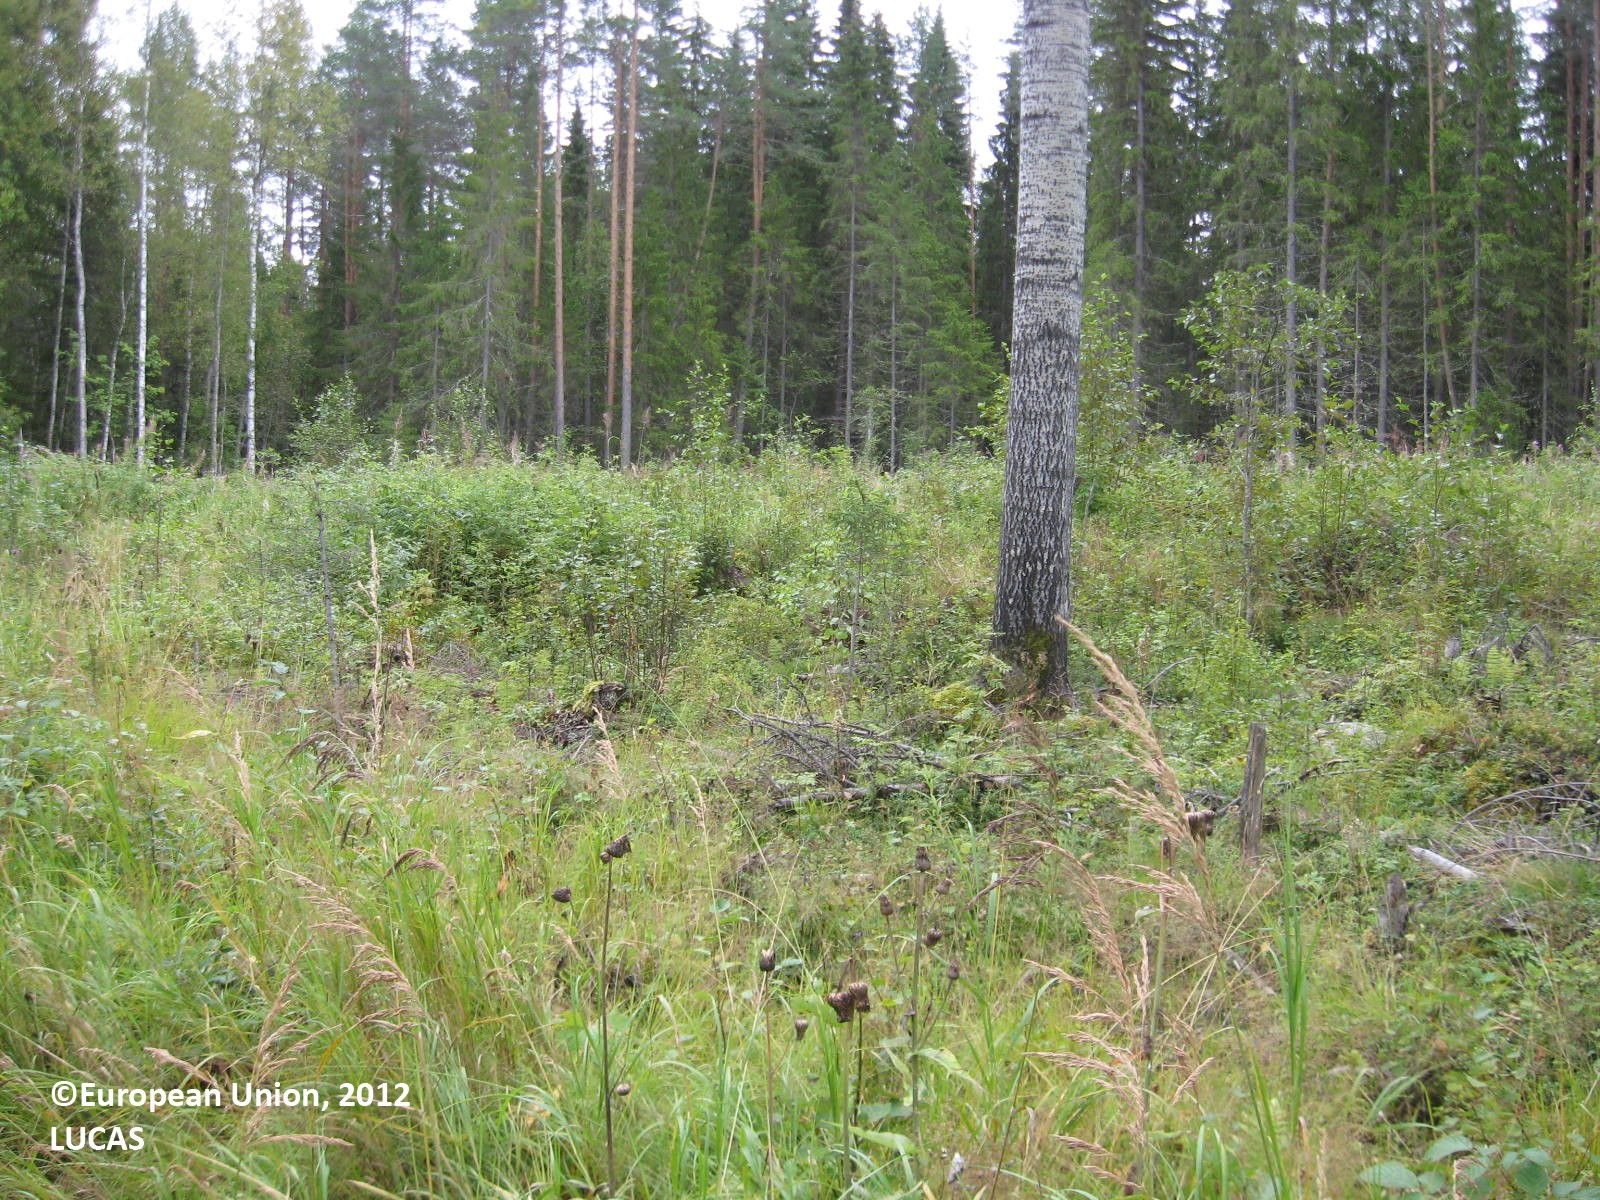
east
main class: Woodland
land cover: Broadleaved woodland
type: boreal forest
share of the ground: 25 - 50 %
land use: Forestry
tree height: > 5 m
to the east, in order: Broadleaved woodland; Pine dominated mixed woodland; Spruce dominated coniferous woodland; Other mixed woodland
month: August
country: FI
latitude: 63.6851
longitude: 29.1141
